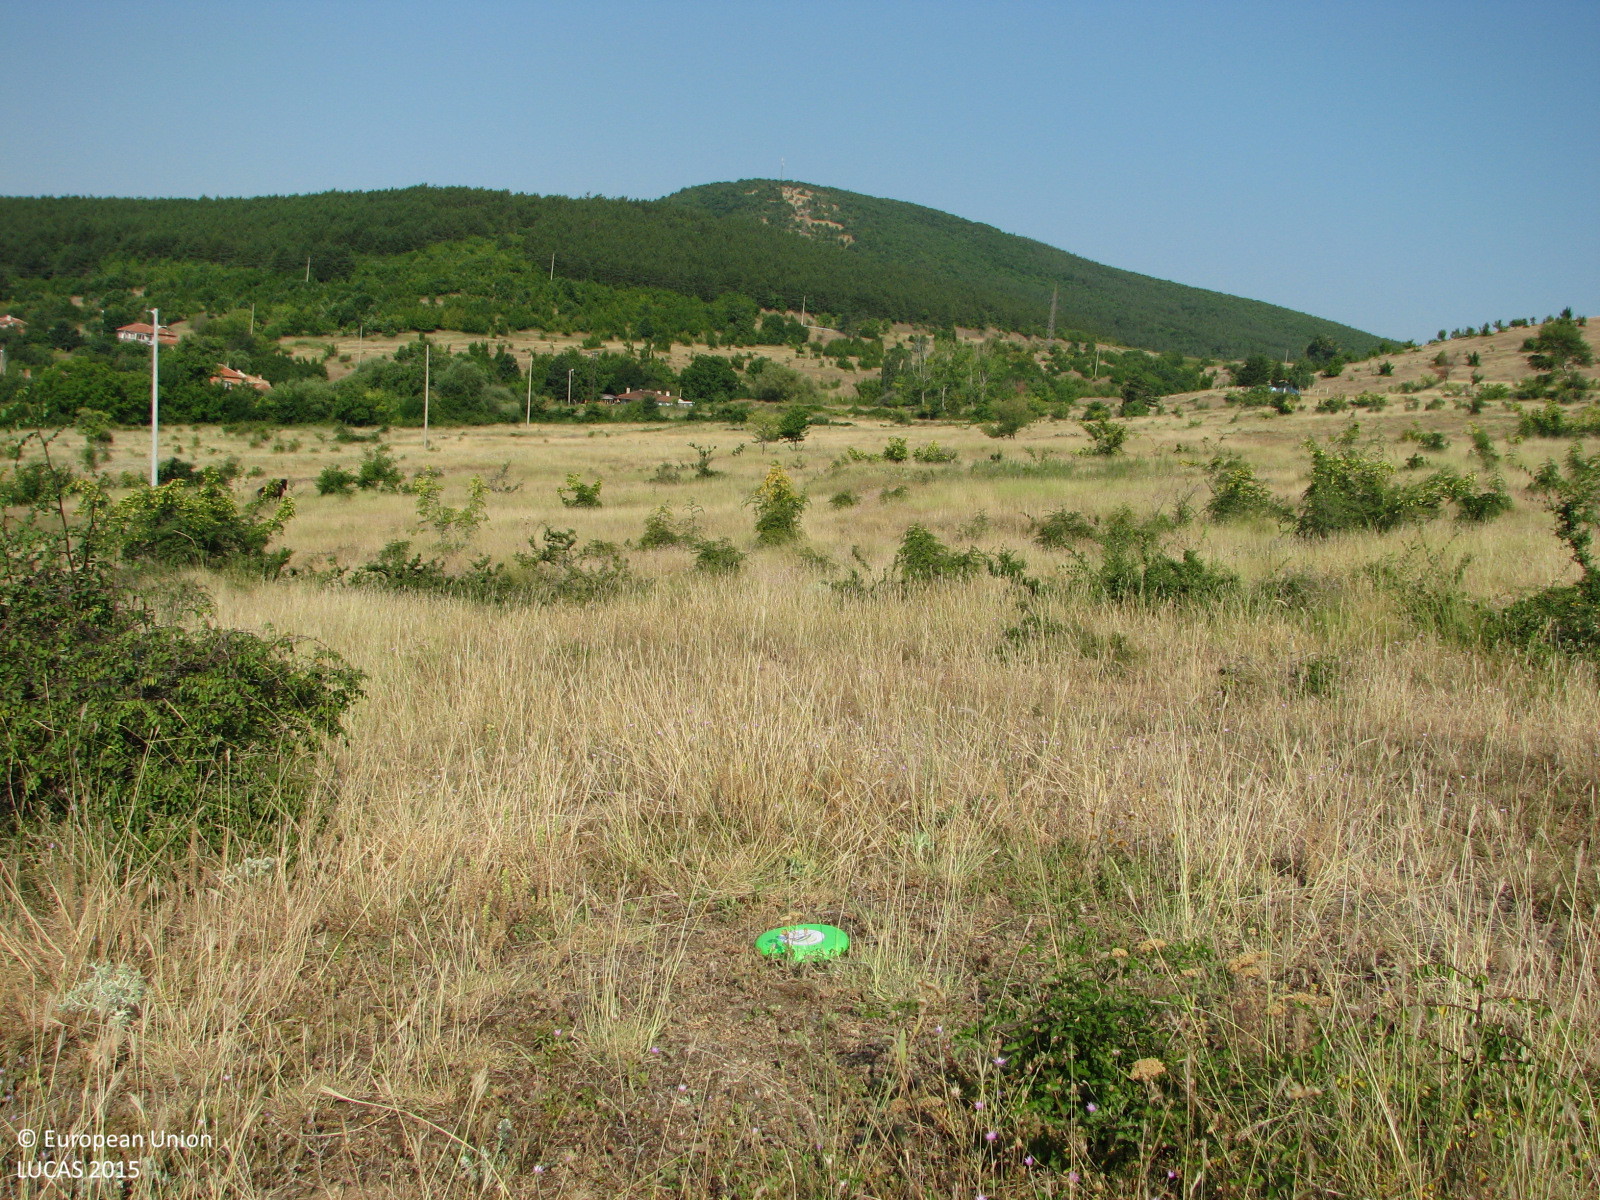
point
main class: Grassland
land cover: Grassland with sparse tree/shrub cover
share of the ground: > 75 %
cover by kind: herbaceous plants 90 %, broadleaved forest trees 5 %, shrubs 5 %
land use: Agriculture (excluding fallow land and kitchen gardens)
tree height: < 5 m
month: July
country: BG
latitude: 42.6526
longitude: 26.1512
